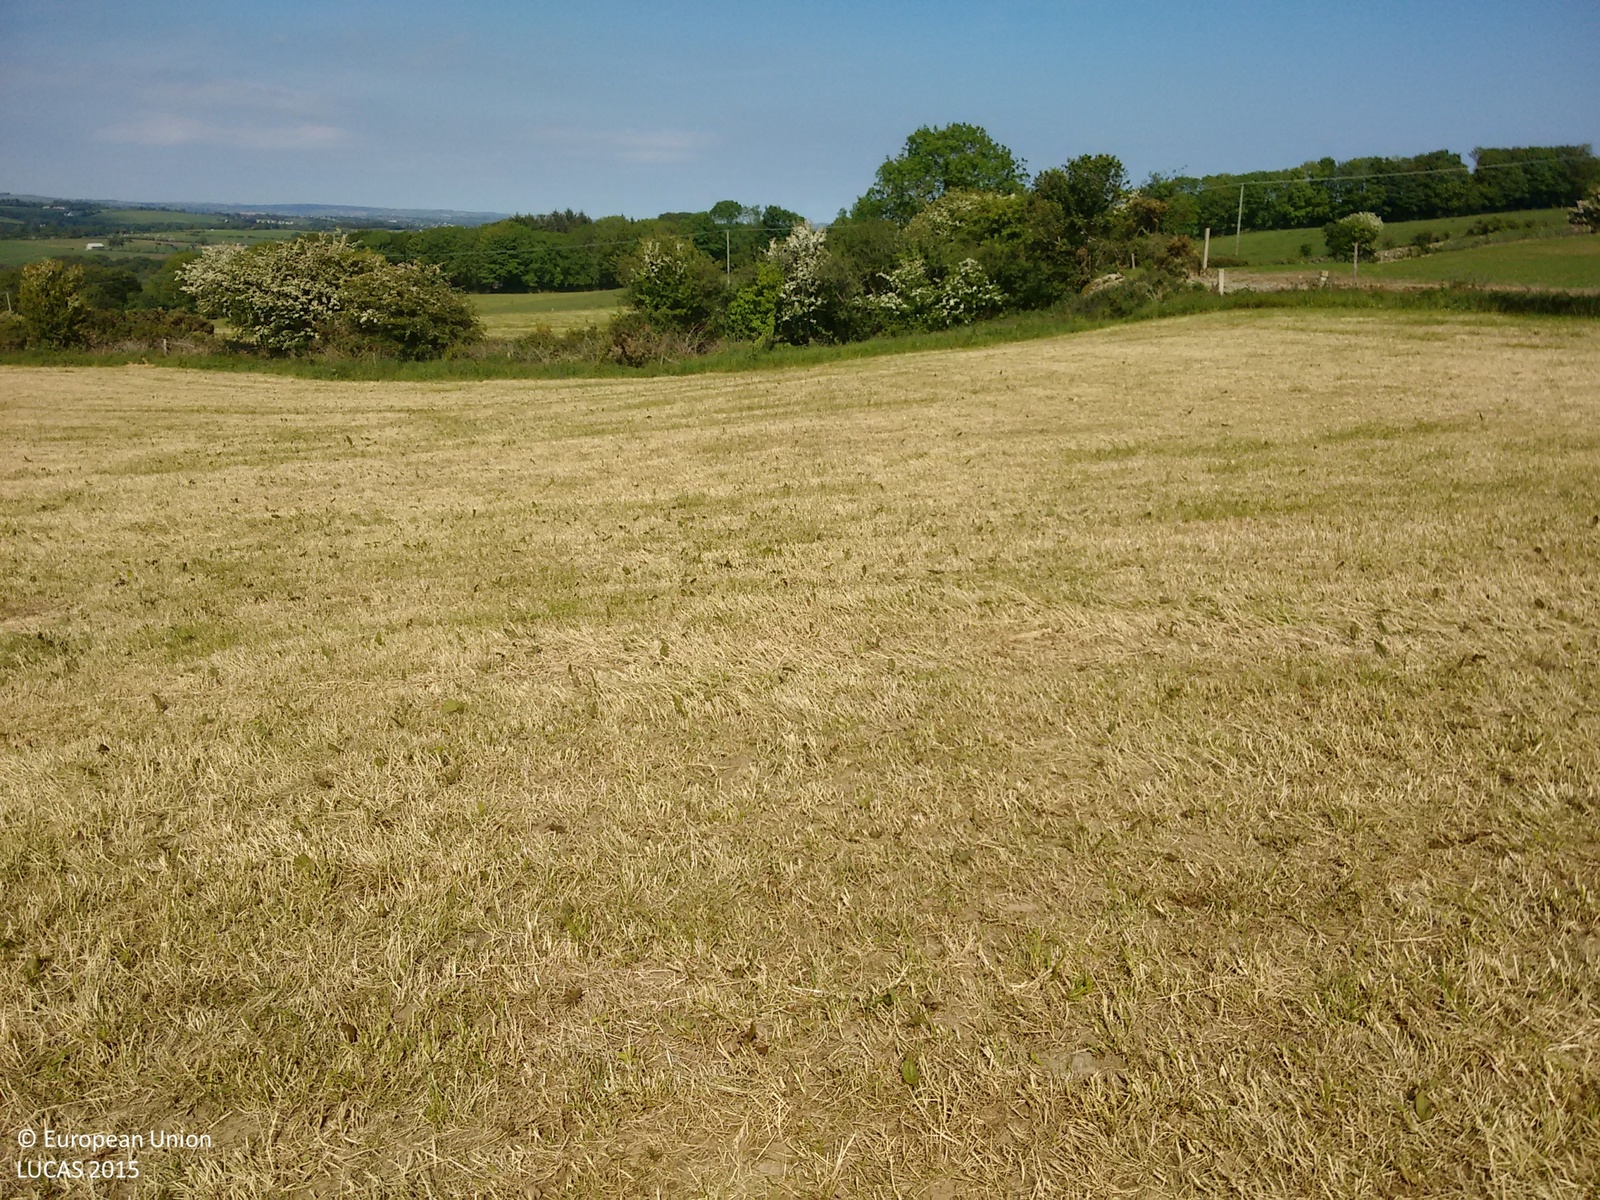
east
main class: Grassland
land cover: Grassland without tree/shrub cover
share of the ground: > 75 %
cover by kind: herbaceous plants 100 %
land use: Agriculture (excluding fallow land and kitchen gardens)
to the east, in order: Grassland without tree/shrub cover; Fences; Tracks; Fences; Grassland without tree/shrub cover; Abandoned hedges; Dry stone walls; Grassland without tree/shrub cover; Electric lines; Grassland without tree/shrub cover; Fences; Grassland without tree/shrub cover
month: June
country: IE
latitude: 51.7227
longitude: -8.8076
